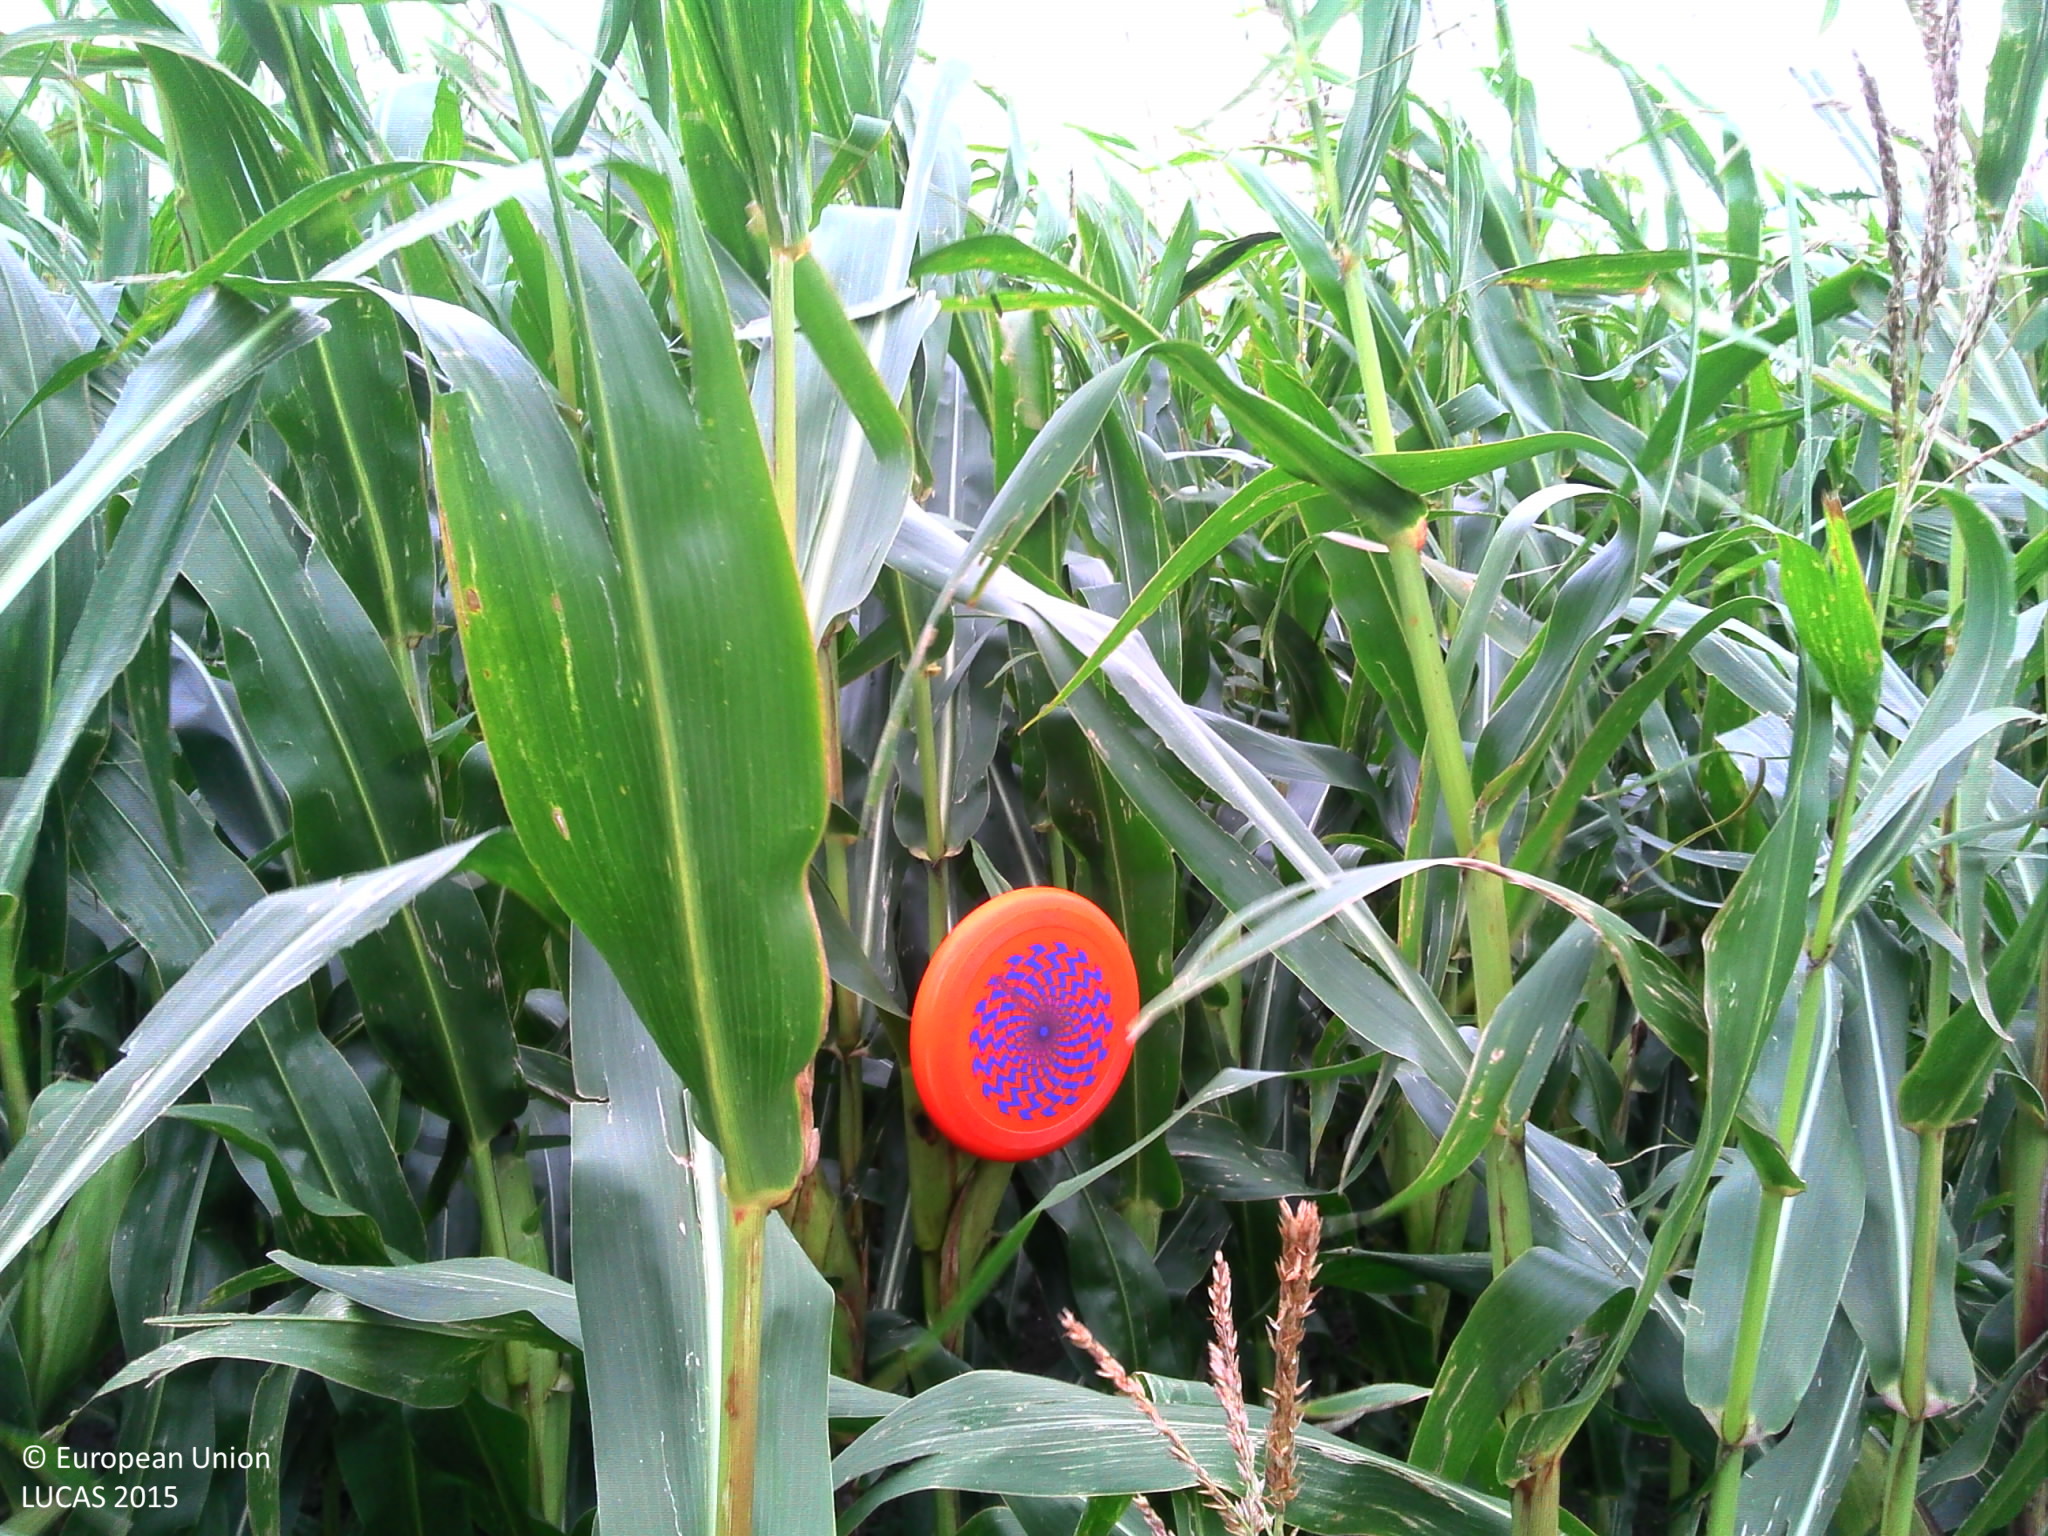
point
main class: Cropland
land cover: Maize
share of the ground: > 75 %
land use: Agriculture (excluding fallow land and kitchen gardens)
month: September
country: BE
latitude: 51.1405
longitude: 2.9719
